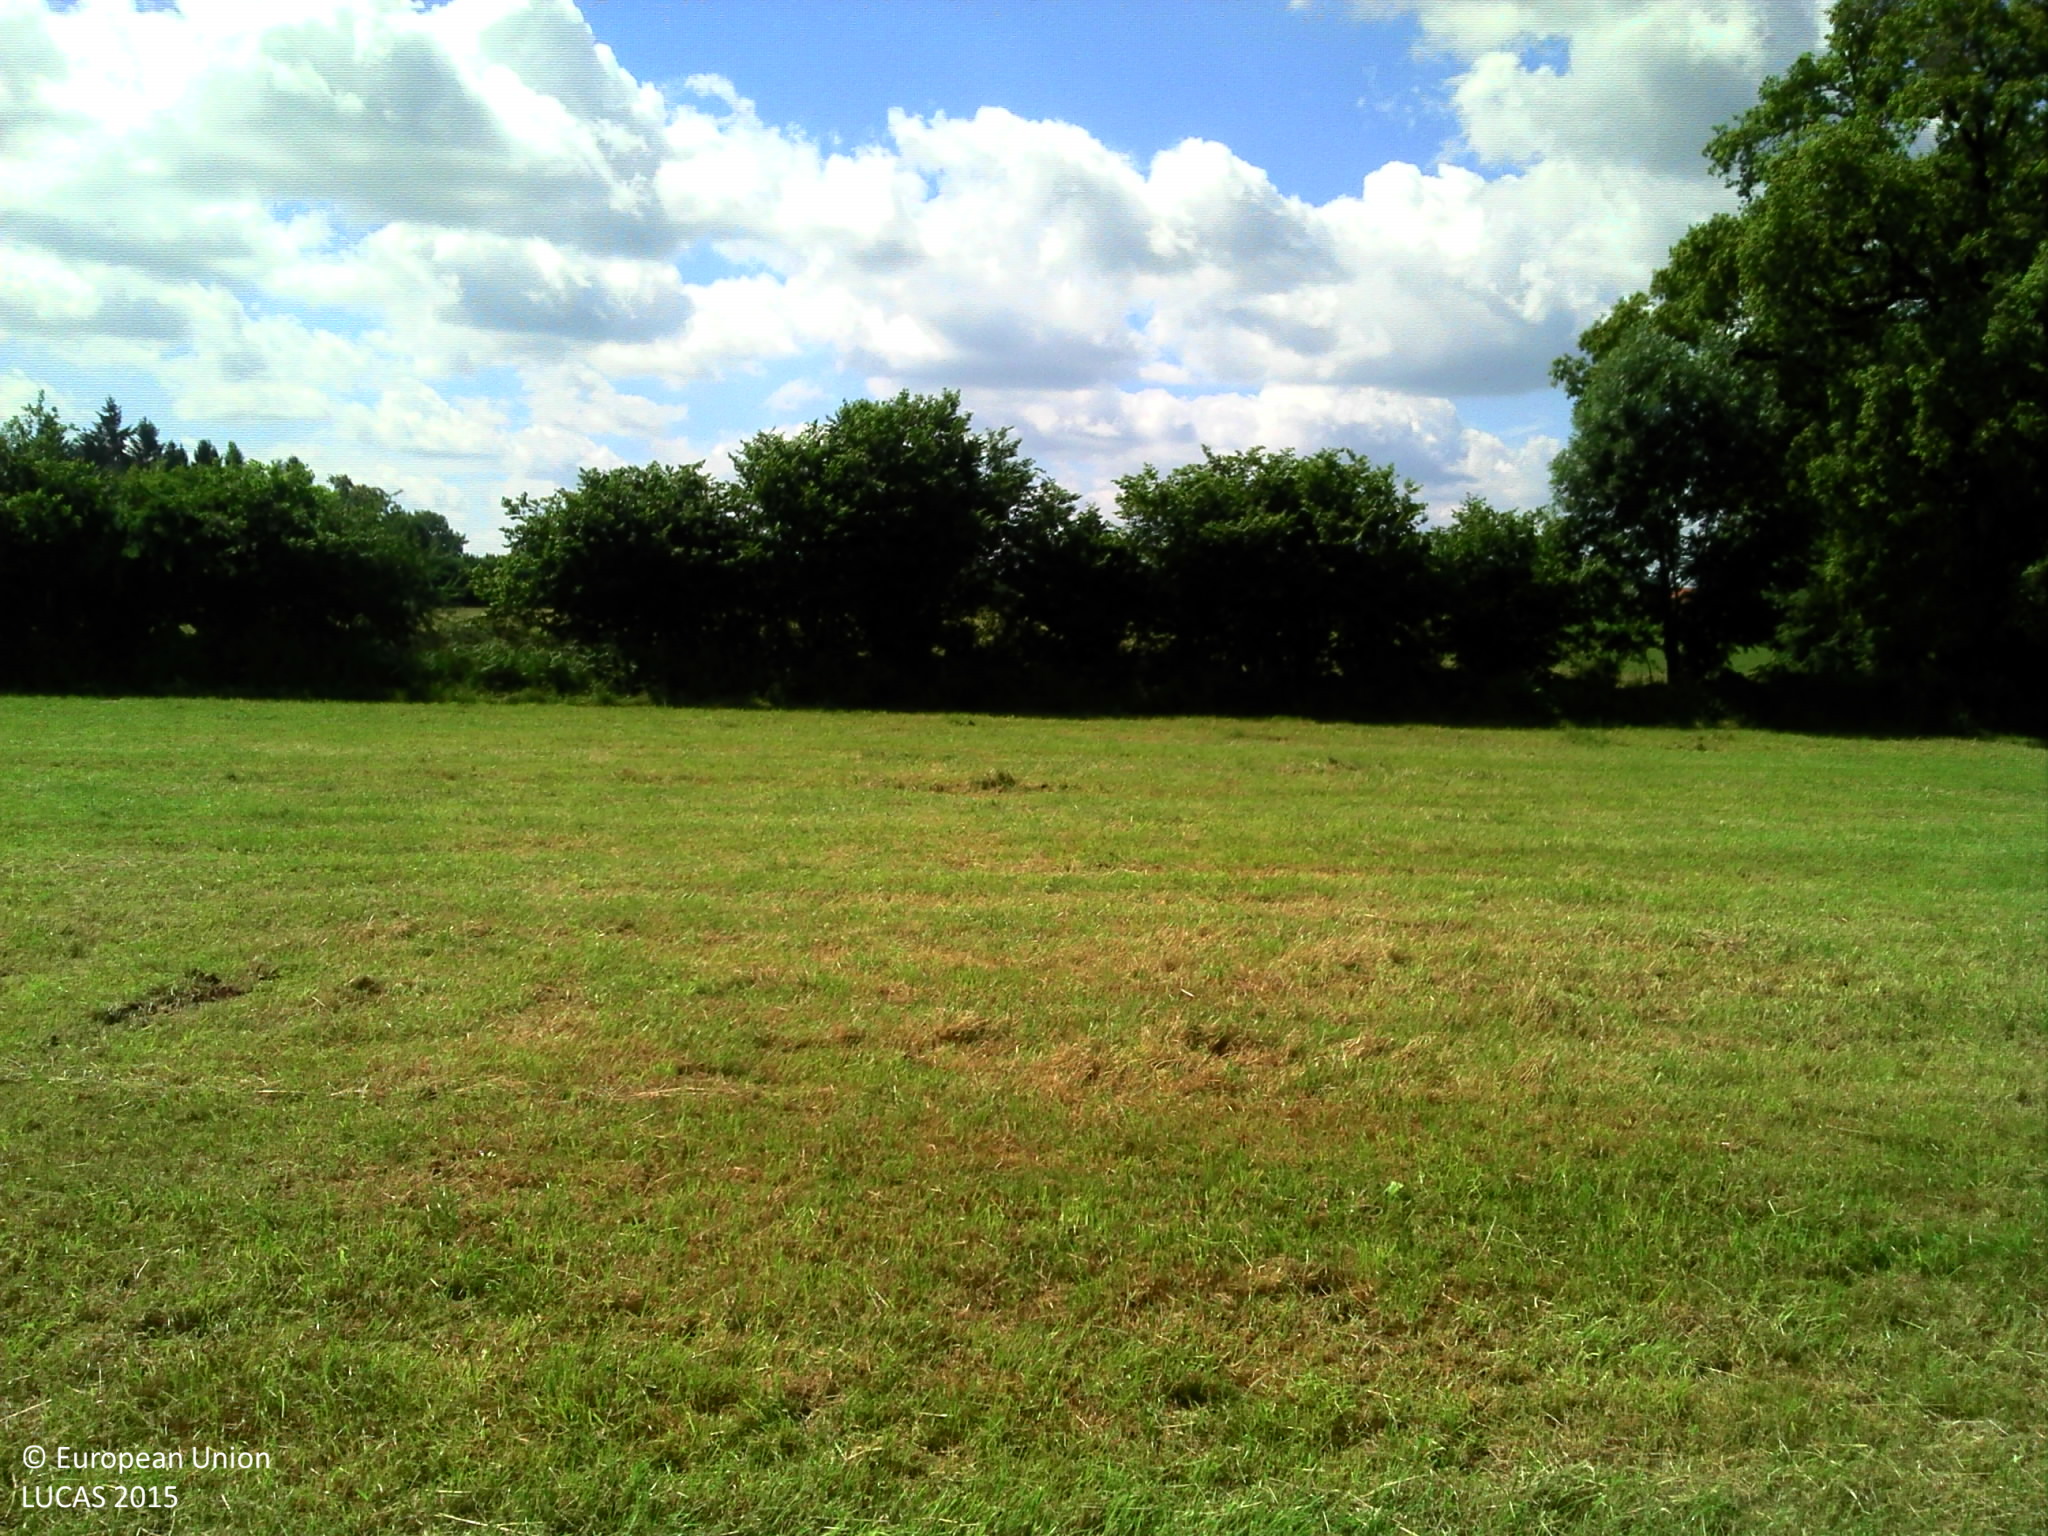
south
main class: Grassland
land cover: Grassland without tree/shrub cover
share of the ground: > 75 %
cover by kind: herbaceous plants 100 %
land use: Agriculture (excluding fallow land and kitchen gardens)
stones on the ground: < 10 %
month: June
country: FR
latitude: 45.2799
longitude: 2.3371
